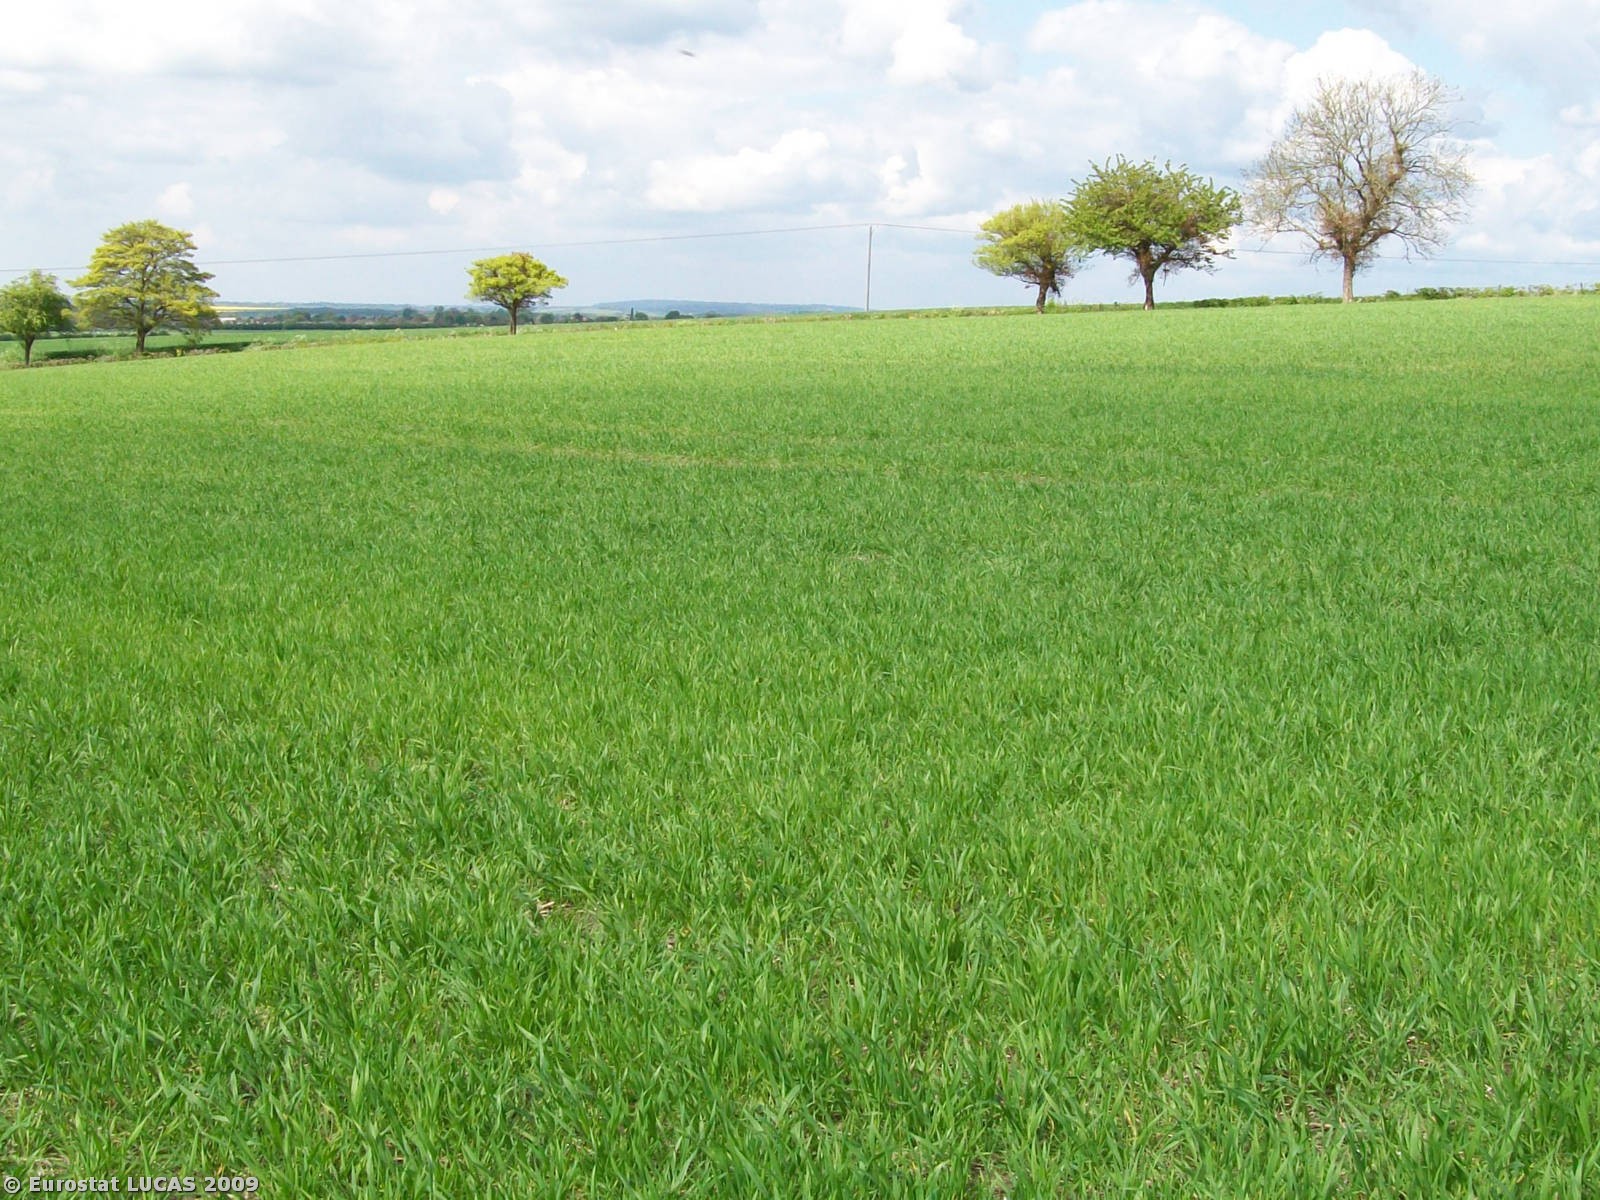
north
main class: Cropland
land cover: Common wheat
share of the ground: 50 - 75 %
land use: Agriculture (excluding fallow land and kitchen gardens)
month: April
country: GB
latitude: 51.6019
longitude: -1.0906
